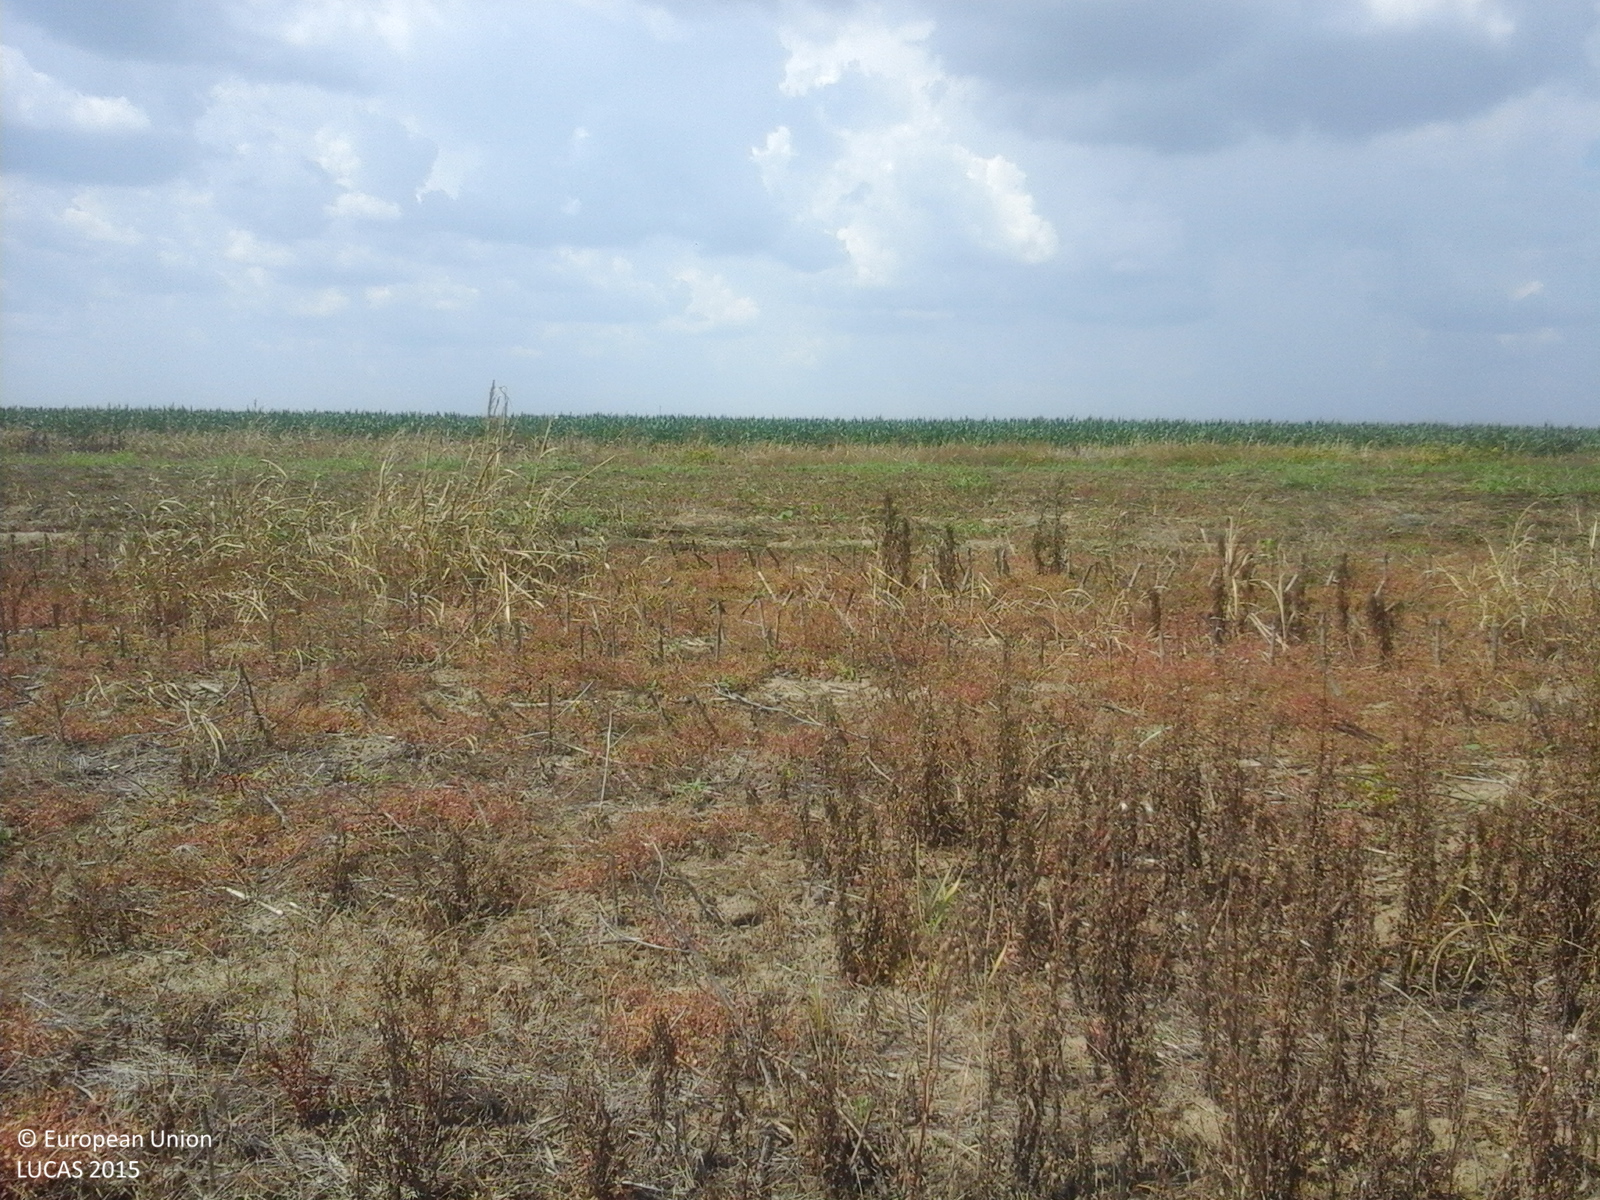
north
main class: Grassland
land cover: Spontaneously vegetated surfaces
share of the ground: > 75 %
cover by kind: herbaceous plants 100 %
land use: Fallow land
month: July
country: RO
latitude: 43.6993
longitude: 25.6851
